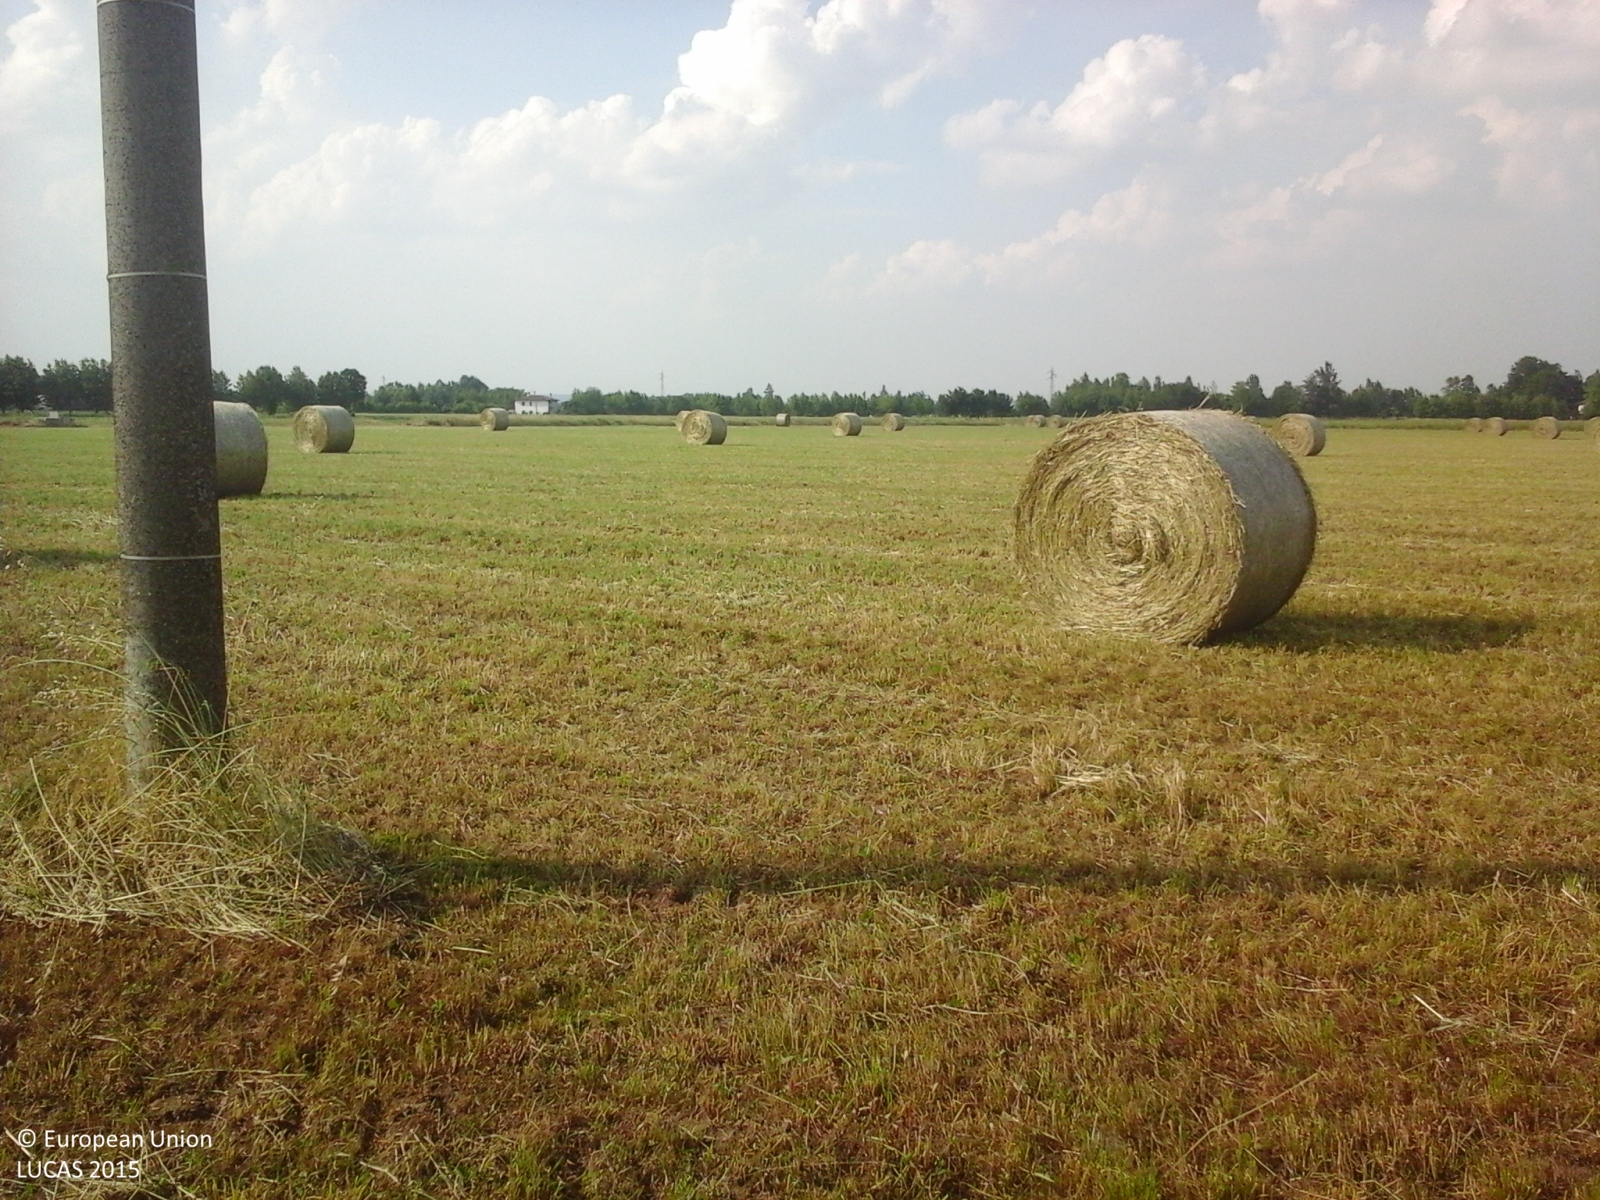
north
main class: Grassland
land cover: Grassland with sparse tree/shrub cover
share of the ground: > 75 %
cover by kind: herbaceous plants 95 %, broadleaved forest trees 5 %
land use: Agriculture (excluding fallow land and kitchen gardens)
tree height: < 5 m
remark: Harvested field
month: May
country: IT
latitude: 45.2501
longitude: 10.6486
